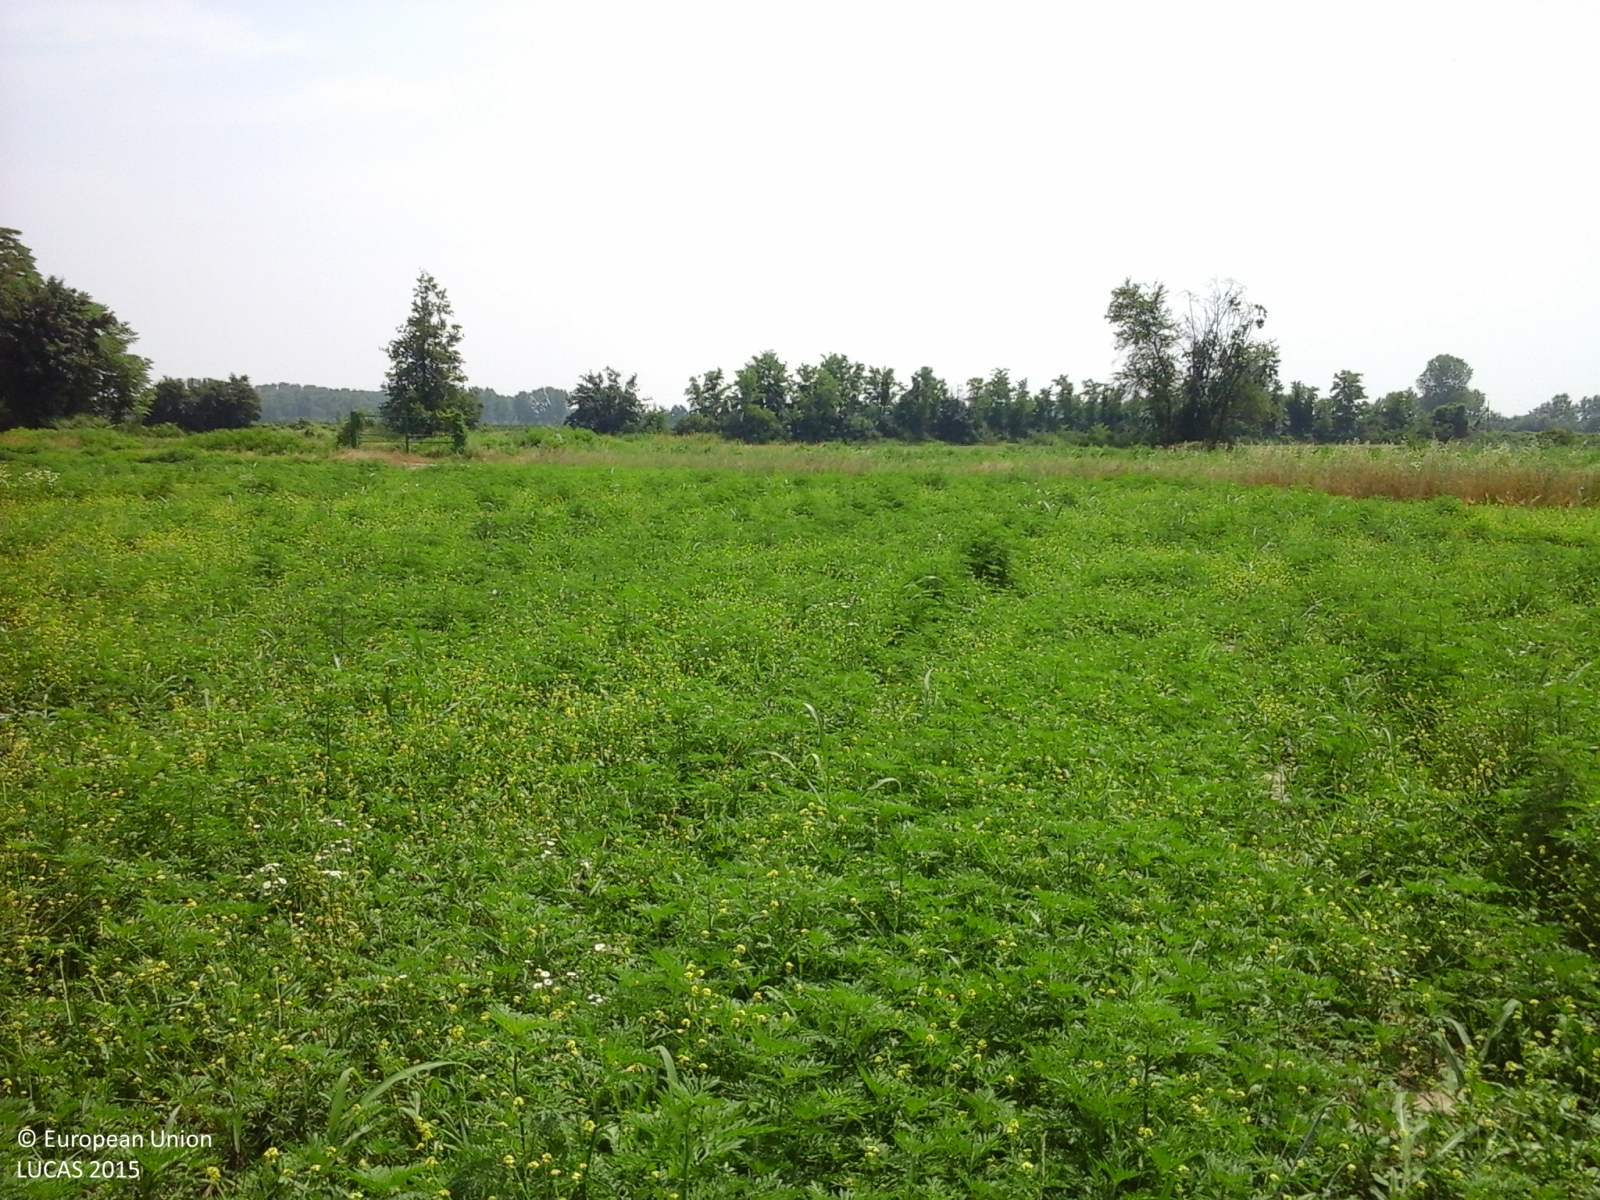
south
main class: Grassland
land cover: Spontaneously vegetated surfaces
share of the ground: > 75 %
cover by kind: herbaceous plants 100 %
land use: Agriculture (excluding fallow land and kitchen gardens)
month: June
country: IT
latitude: 45.2695
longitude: 9.6565
